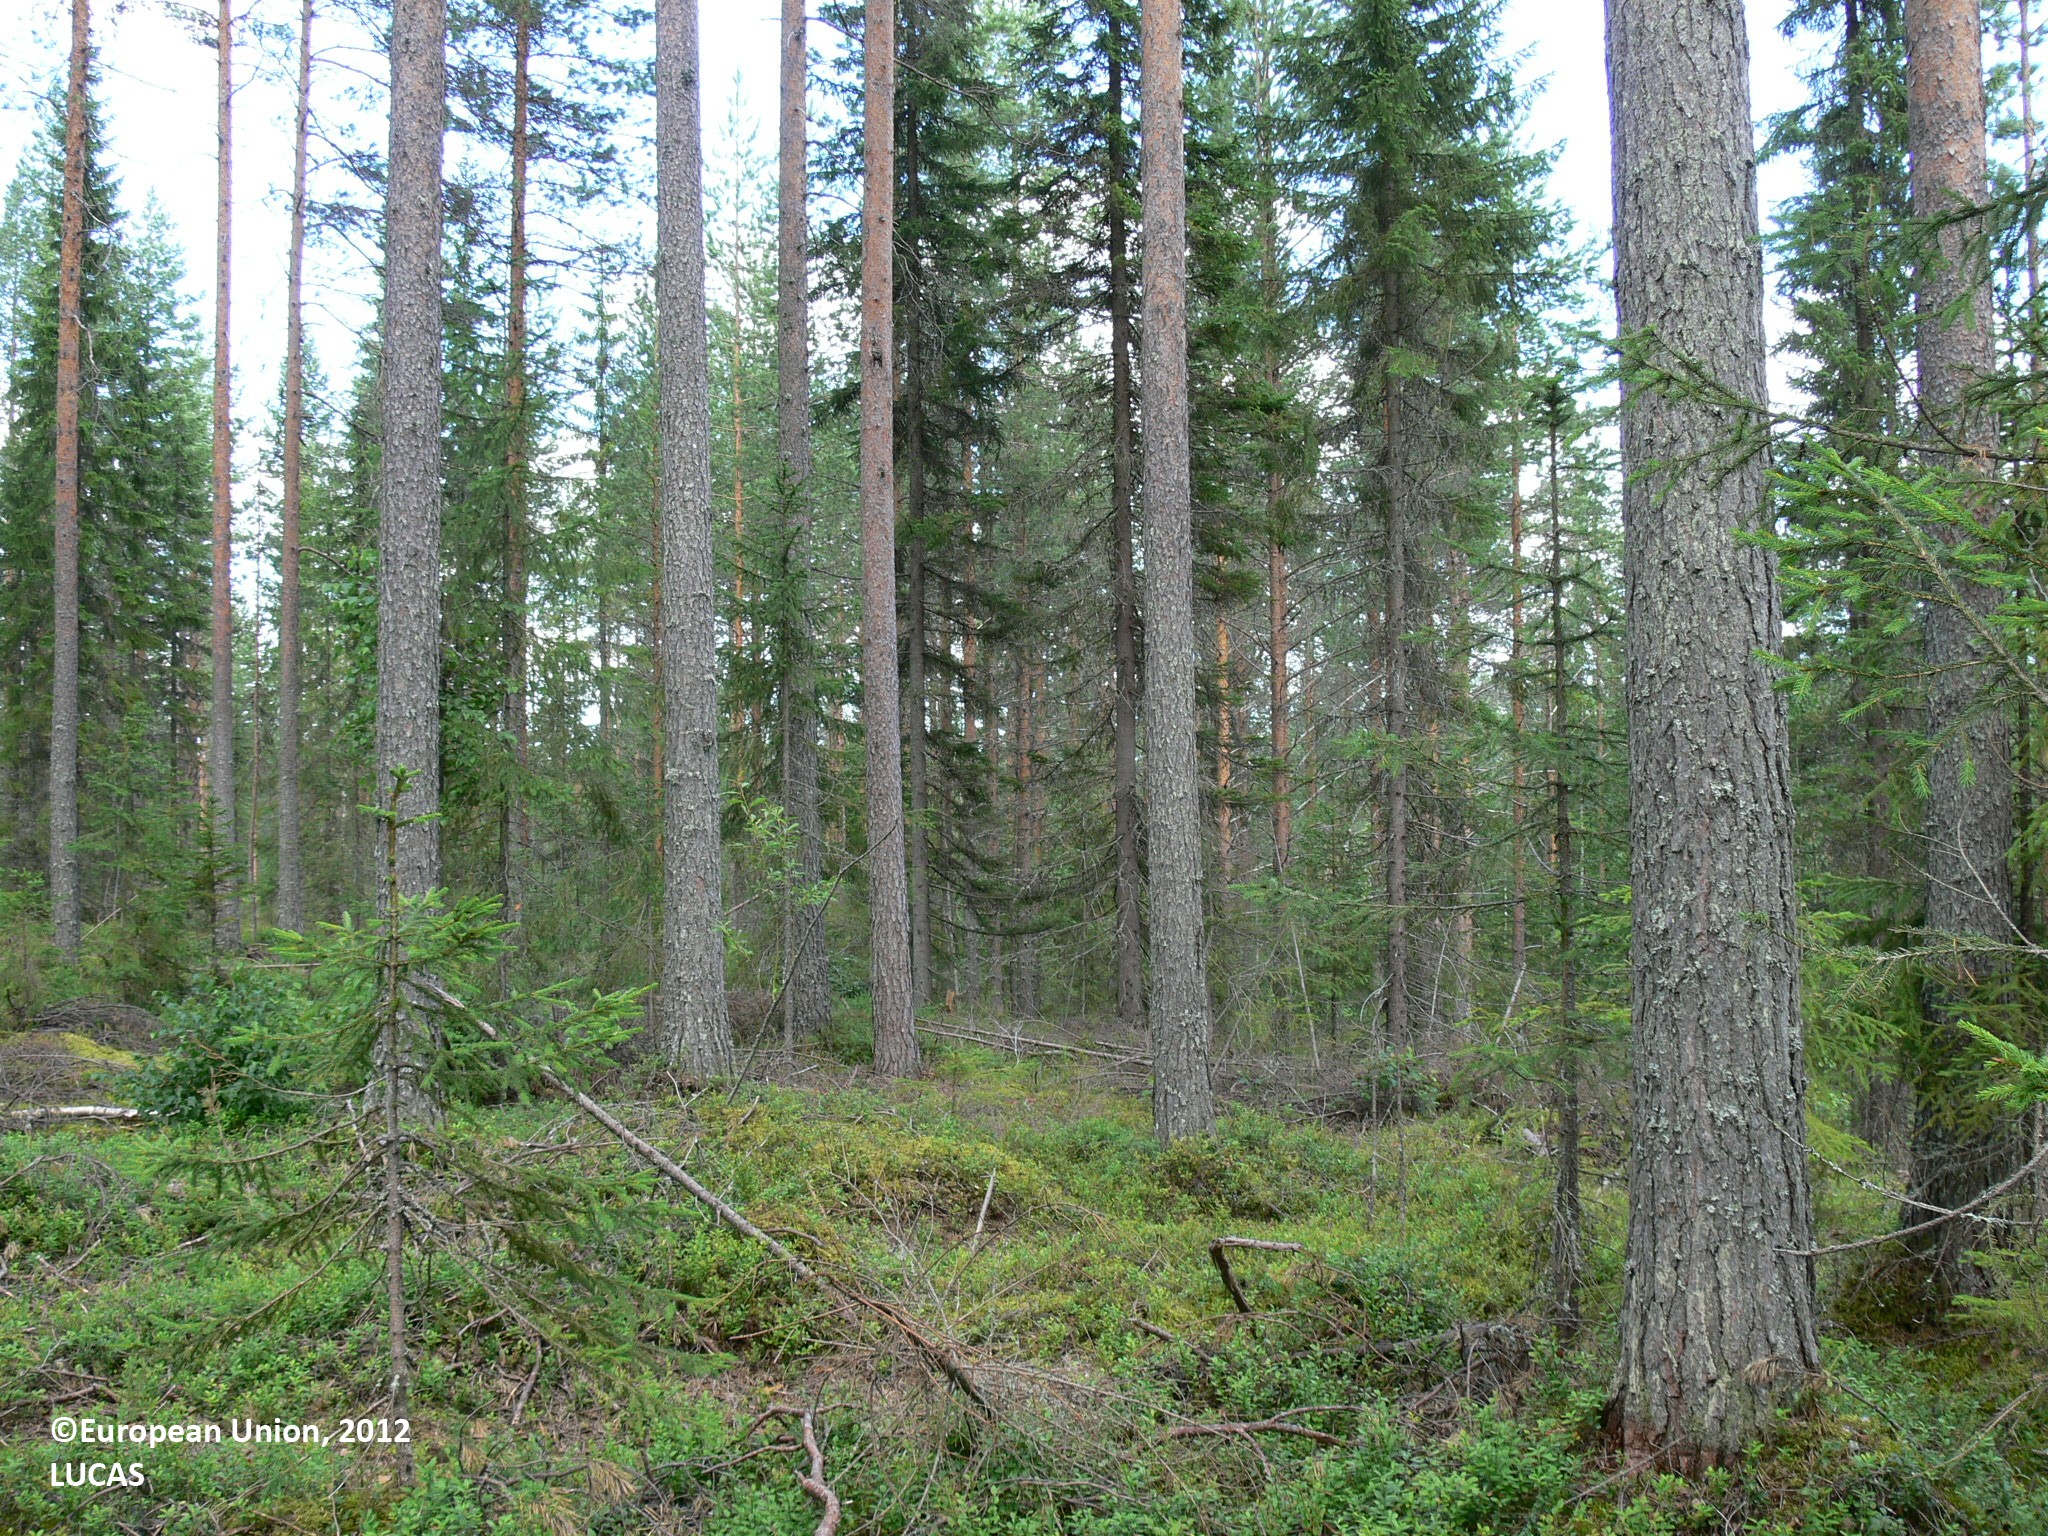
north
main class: Woodland
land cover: Pine dominated coniferous woodland
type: boreal forest
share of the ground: 50 - 75 %
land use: Forestry
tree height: > 5 m
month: July
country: FI
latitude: 63.2004
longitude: 29.2461
